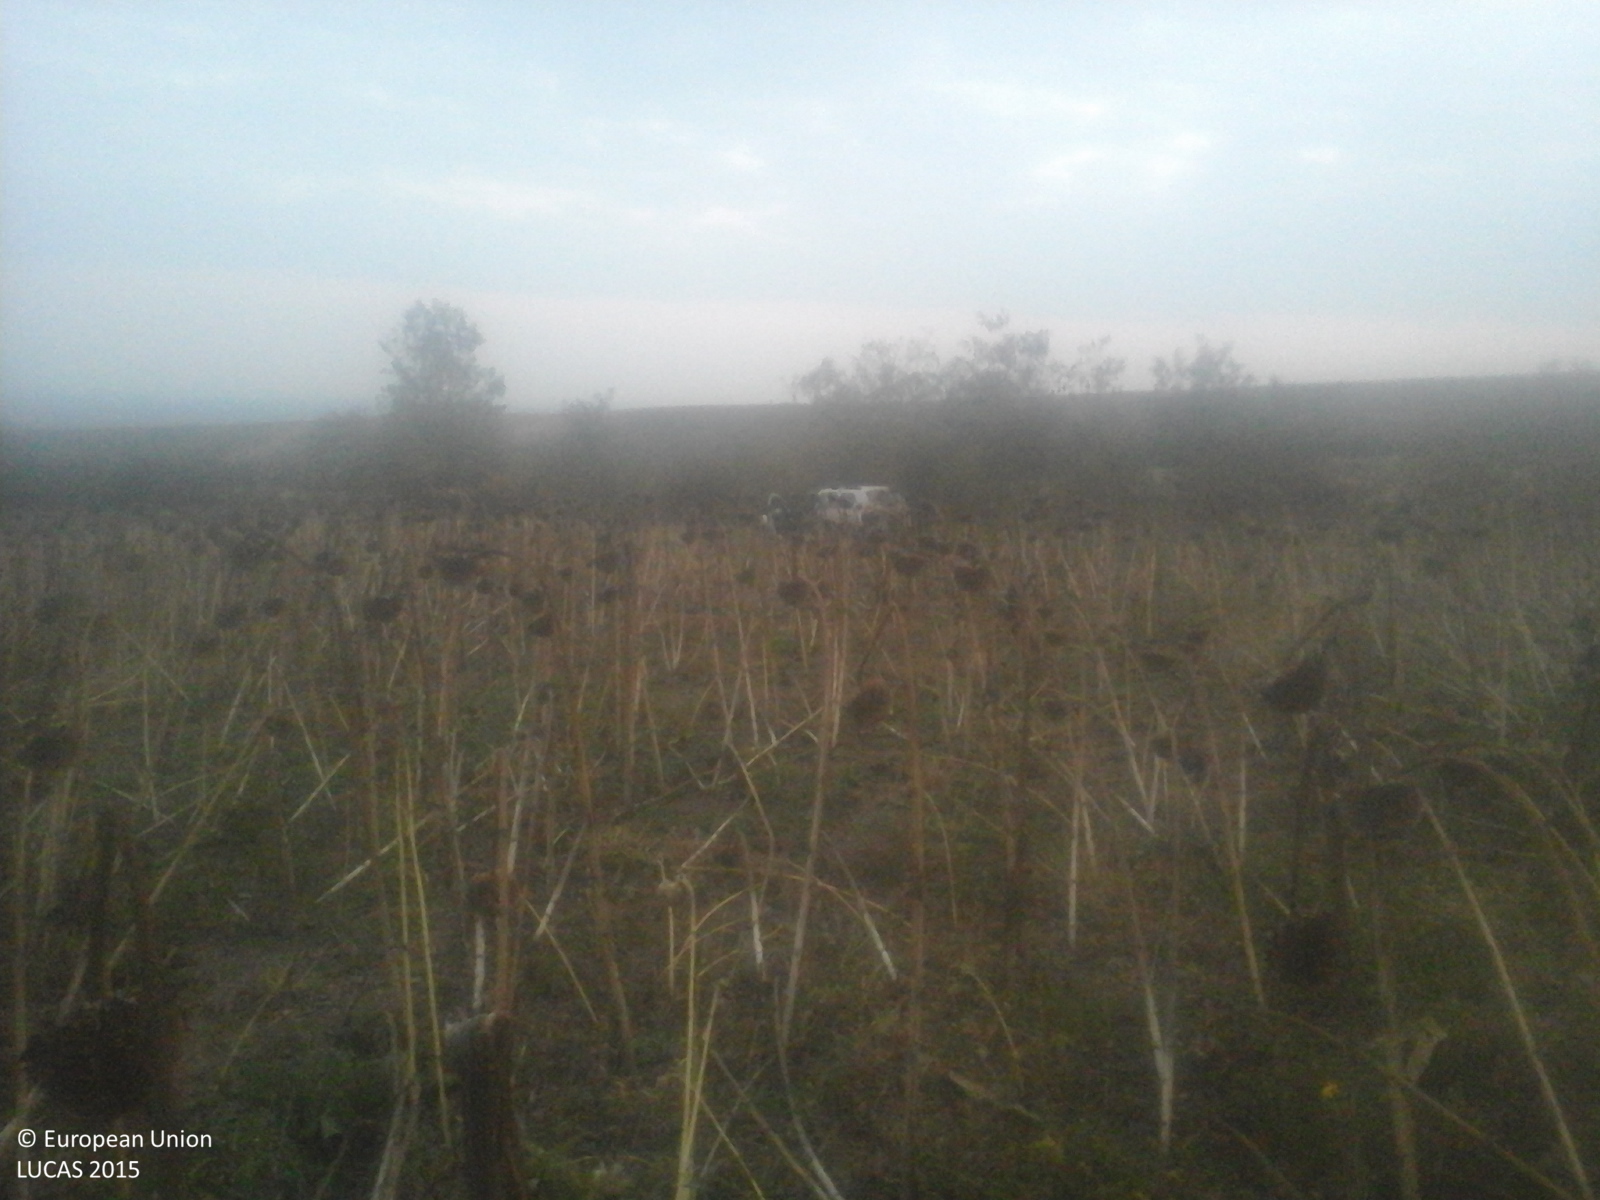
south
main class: Cropland
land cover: Sunflower
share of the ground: 25 - 50 %
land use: Agriculture (excluding fallow land and kitchen gardens)
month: October
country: RO
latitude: 45.3580
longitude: 26.9223
